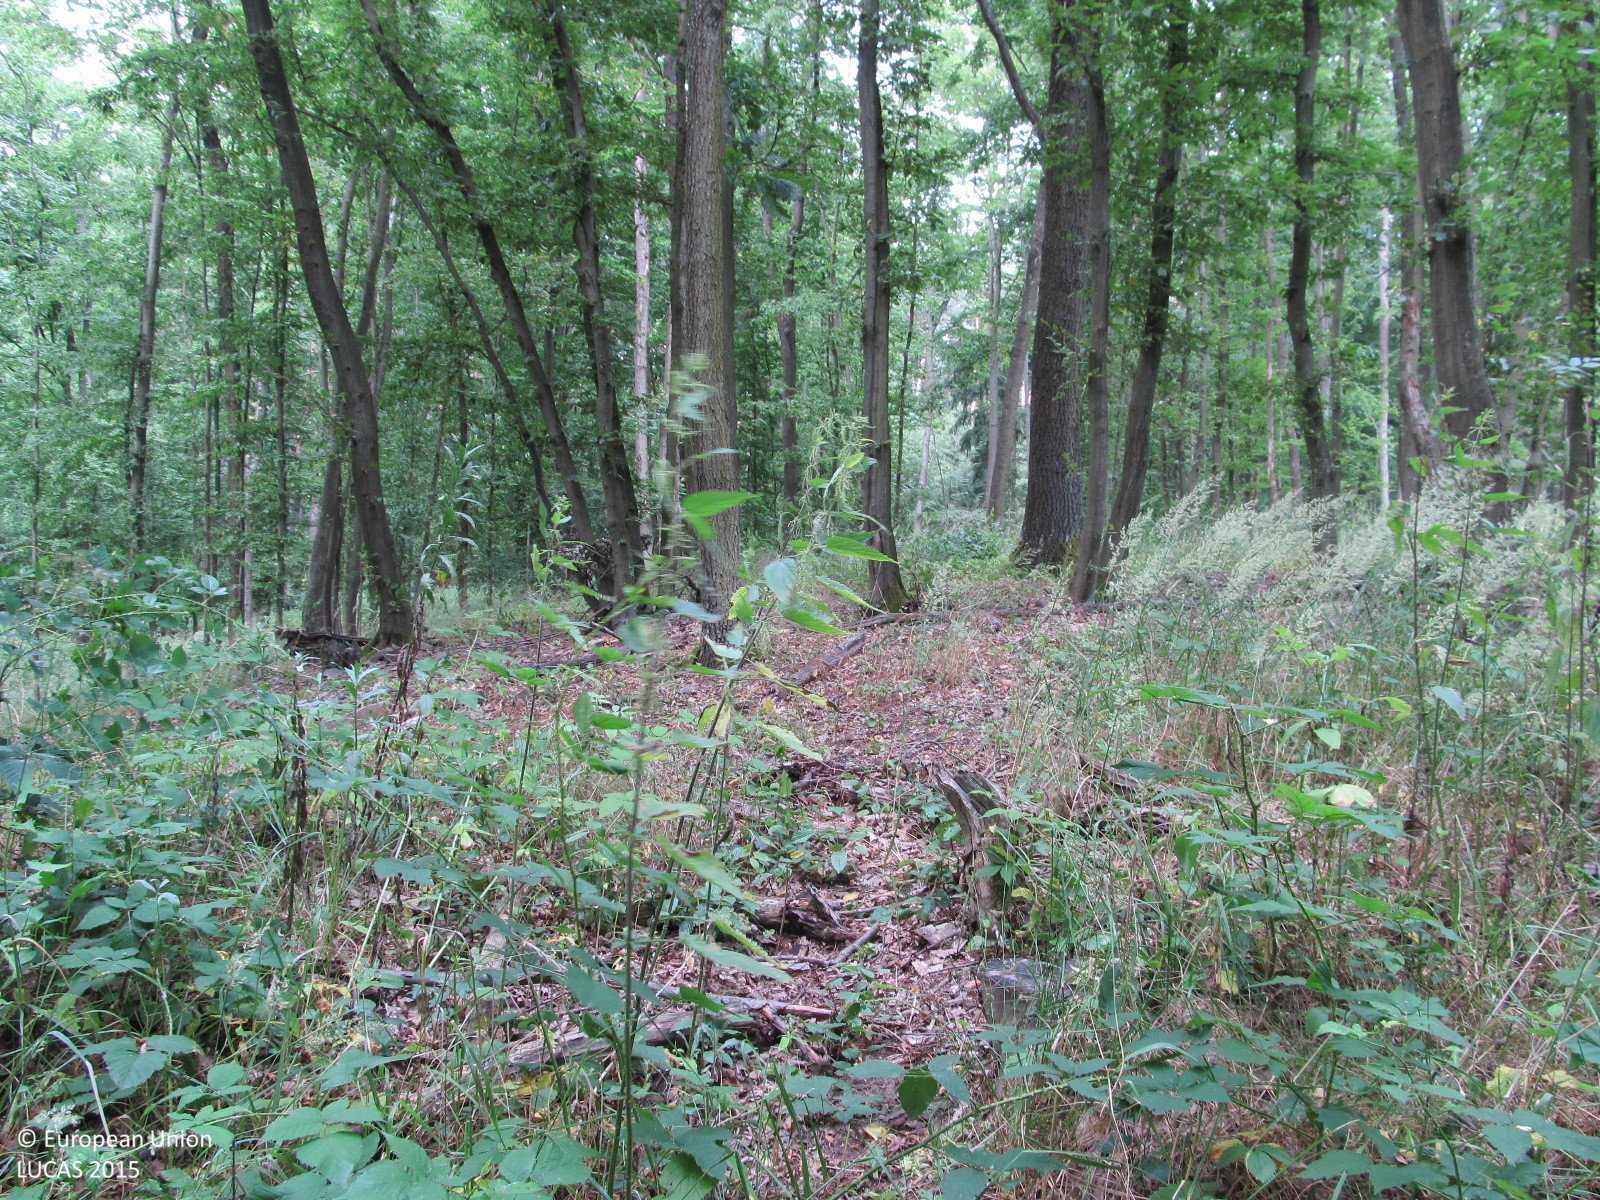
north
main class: Woodland
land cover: Broadleaved woodland
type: mountainous beech forest
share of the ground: 50 - 75 %
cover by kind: broadleaved forest trees 60 %, shrubs 30 %, unconsolidated bare surface 10 %
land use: Forestry
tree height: < 5 m
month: July
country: AT
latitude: 48.7901
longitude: 15.8435
